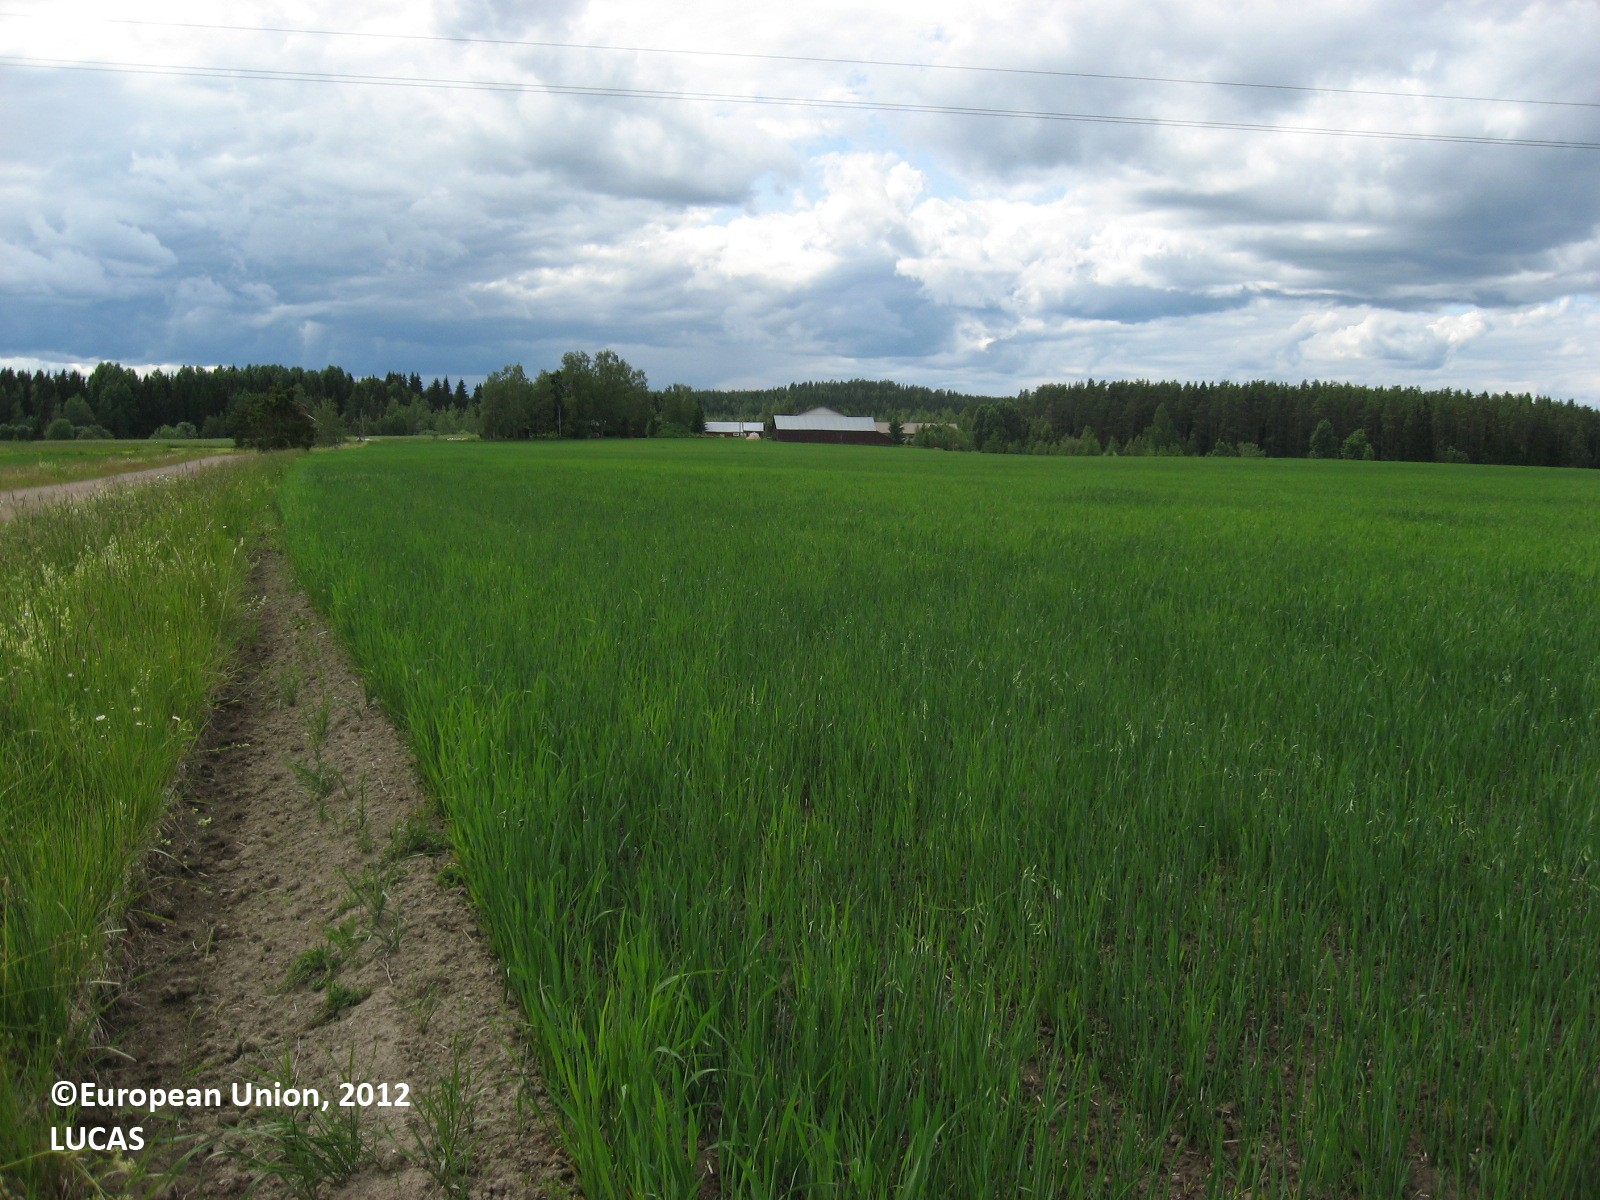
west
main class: Cropland
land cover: Oats
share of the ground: > 75 %
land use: Agriculture (excluding fallow land and kitchen gardens)
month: June
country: FI
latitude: 60.7707
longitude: 26.4739
